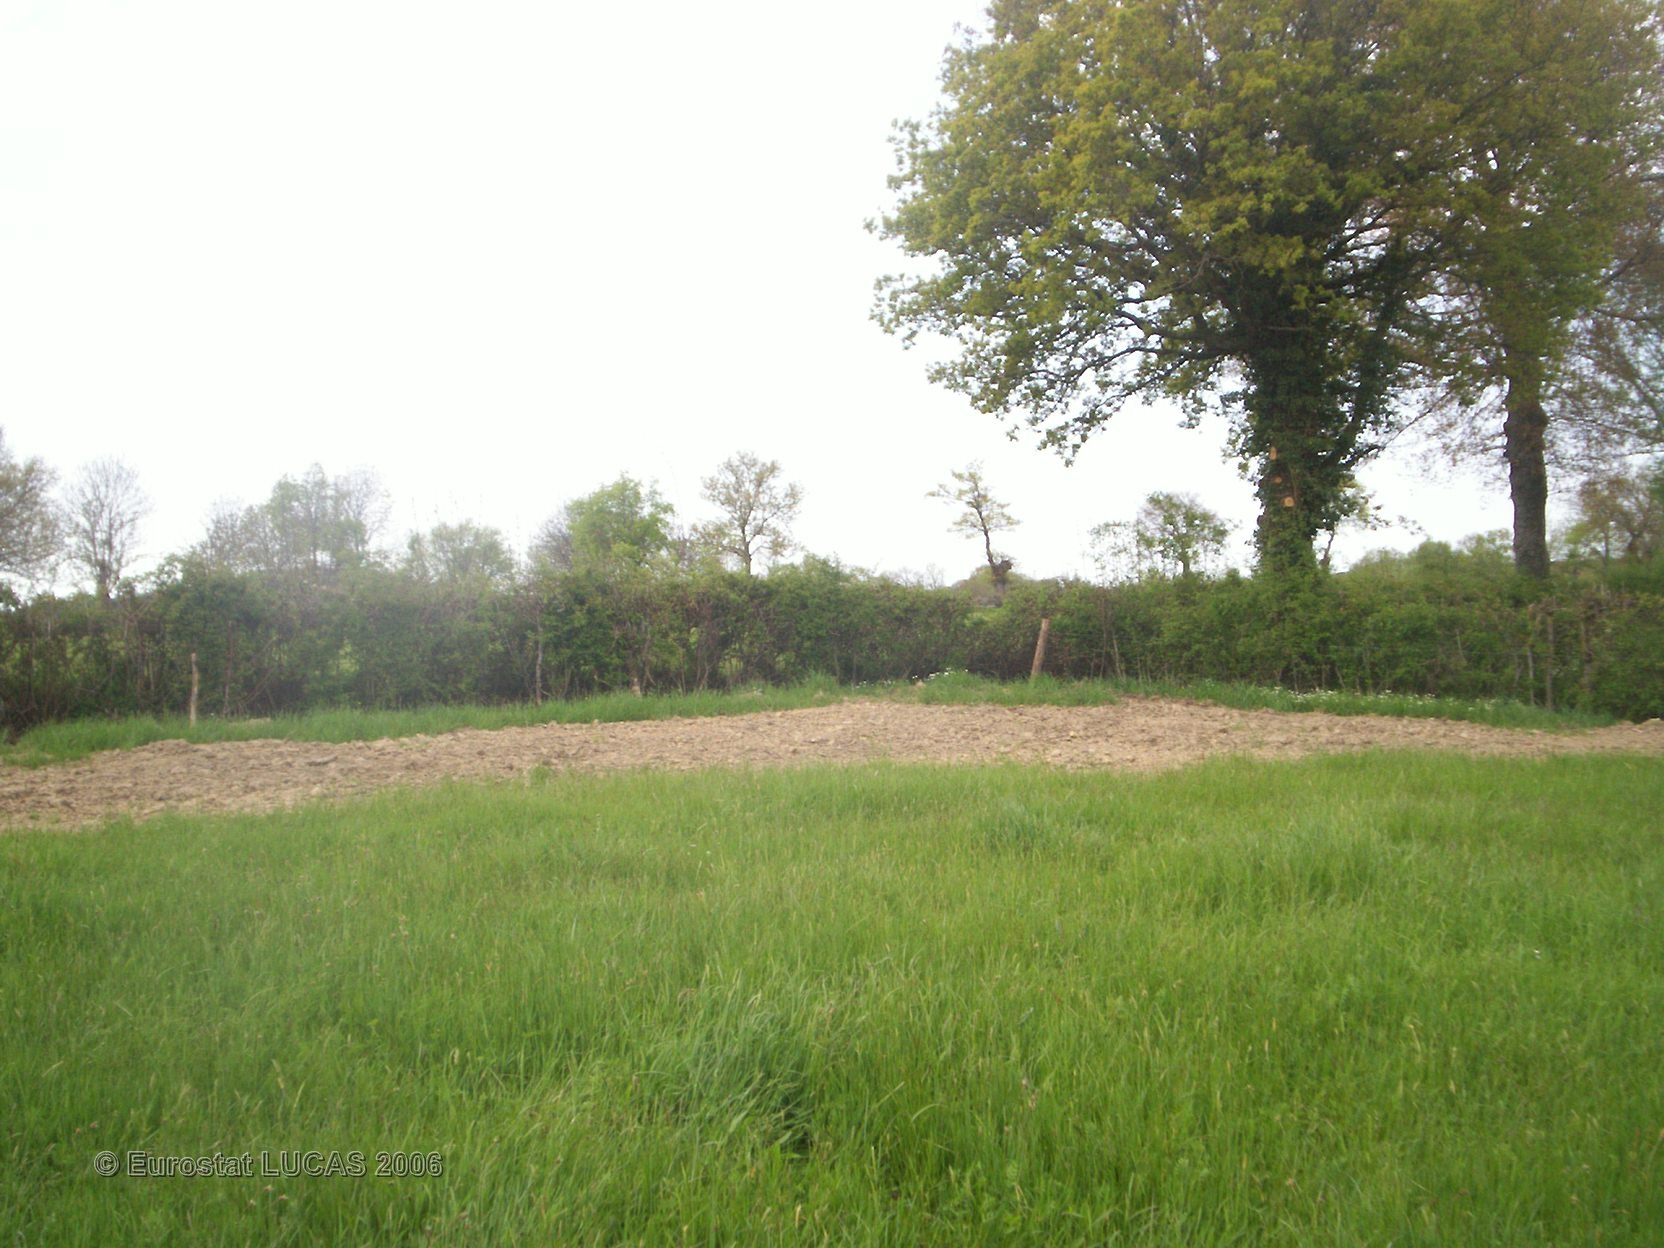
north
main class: Grassland
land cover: Grassland without tree/shrub cover
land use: Agriculture (excluding fallow land and kitchen gardens)
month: May
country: FR
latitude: 46.4380
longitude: 3.1387
